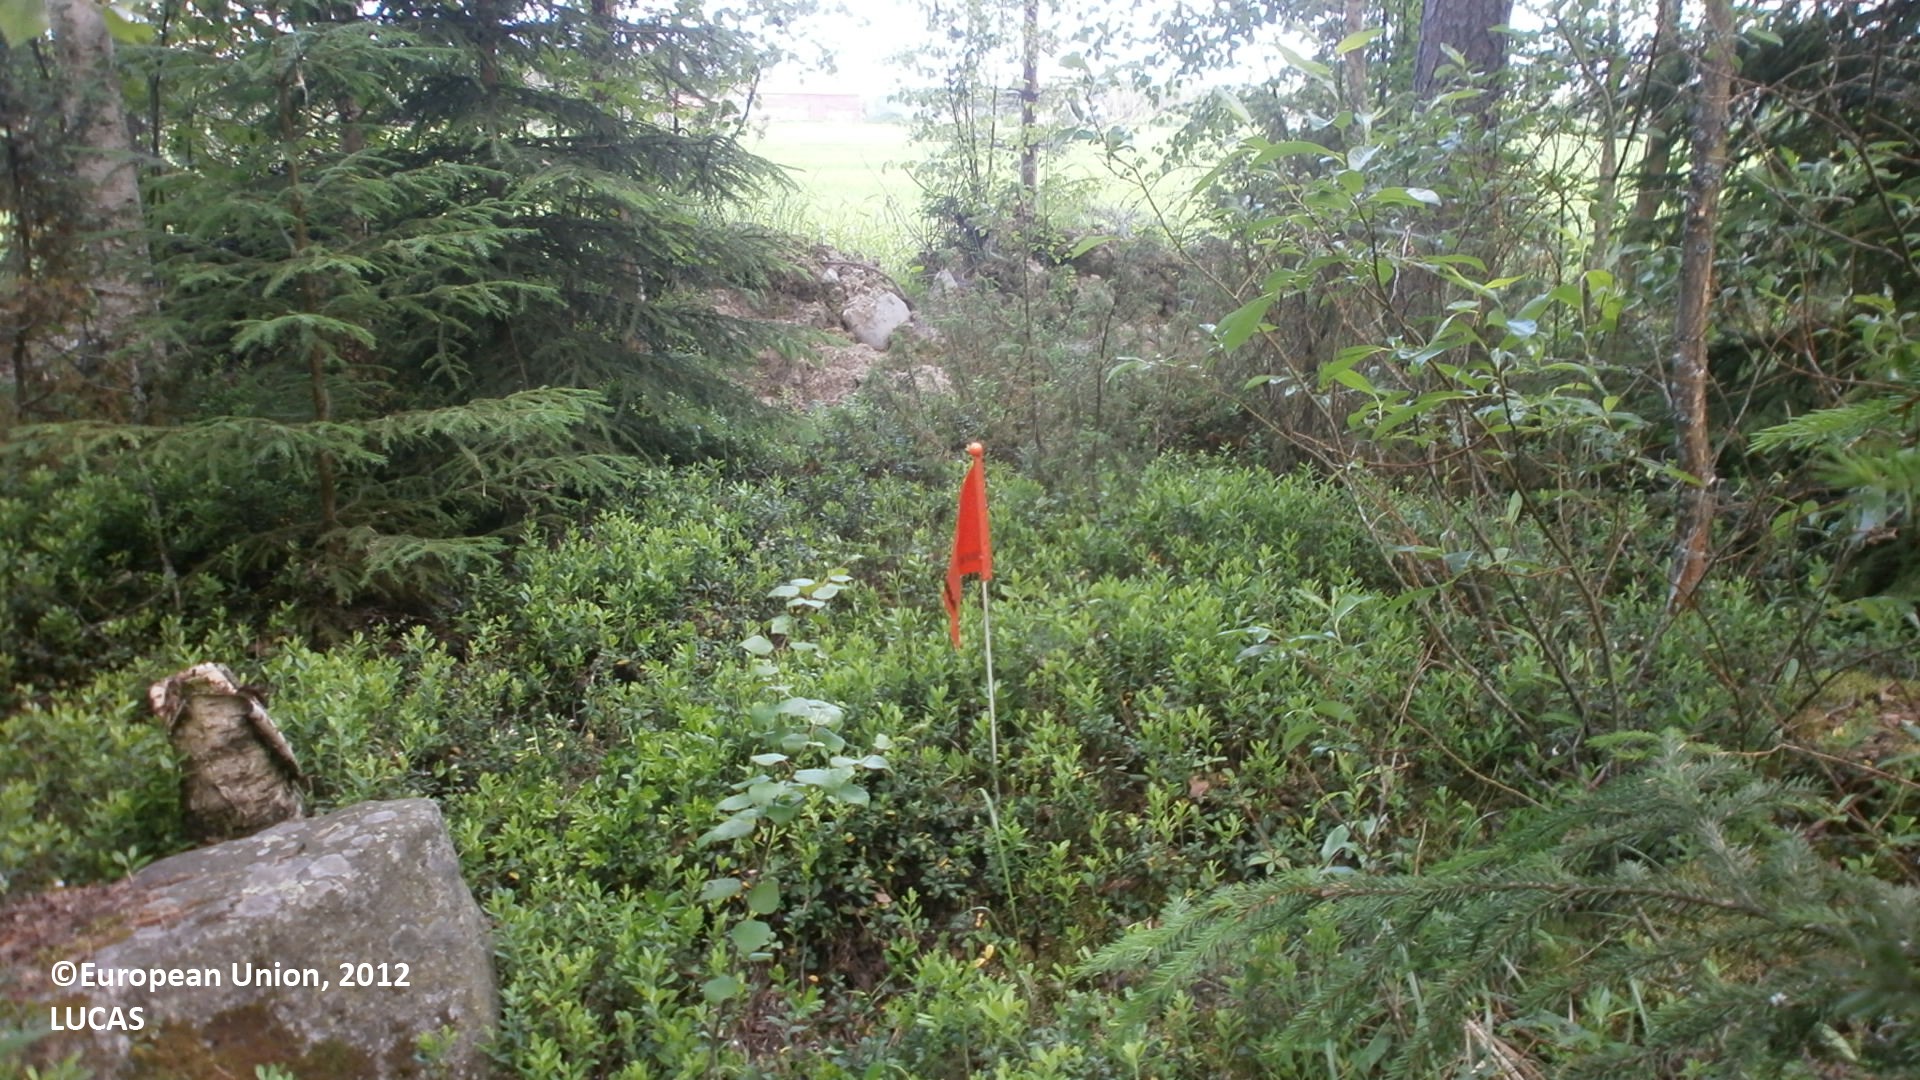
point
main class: Woodland
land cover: Pine dominated mixed woodland
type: boreal forest
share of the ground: > 75 %
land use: Forestry
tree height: > 5 m
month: July
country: FI
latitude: 63.9608
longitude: 24.7602
